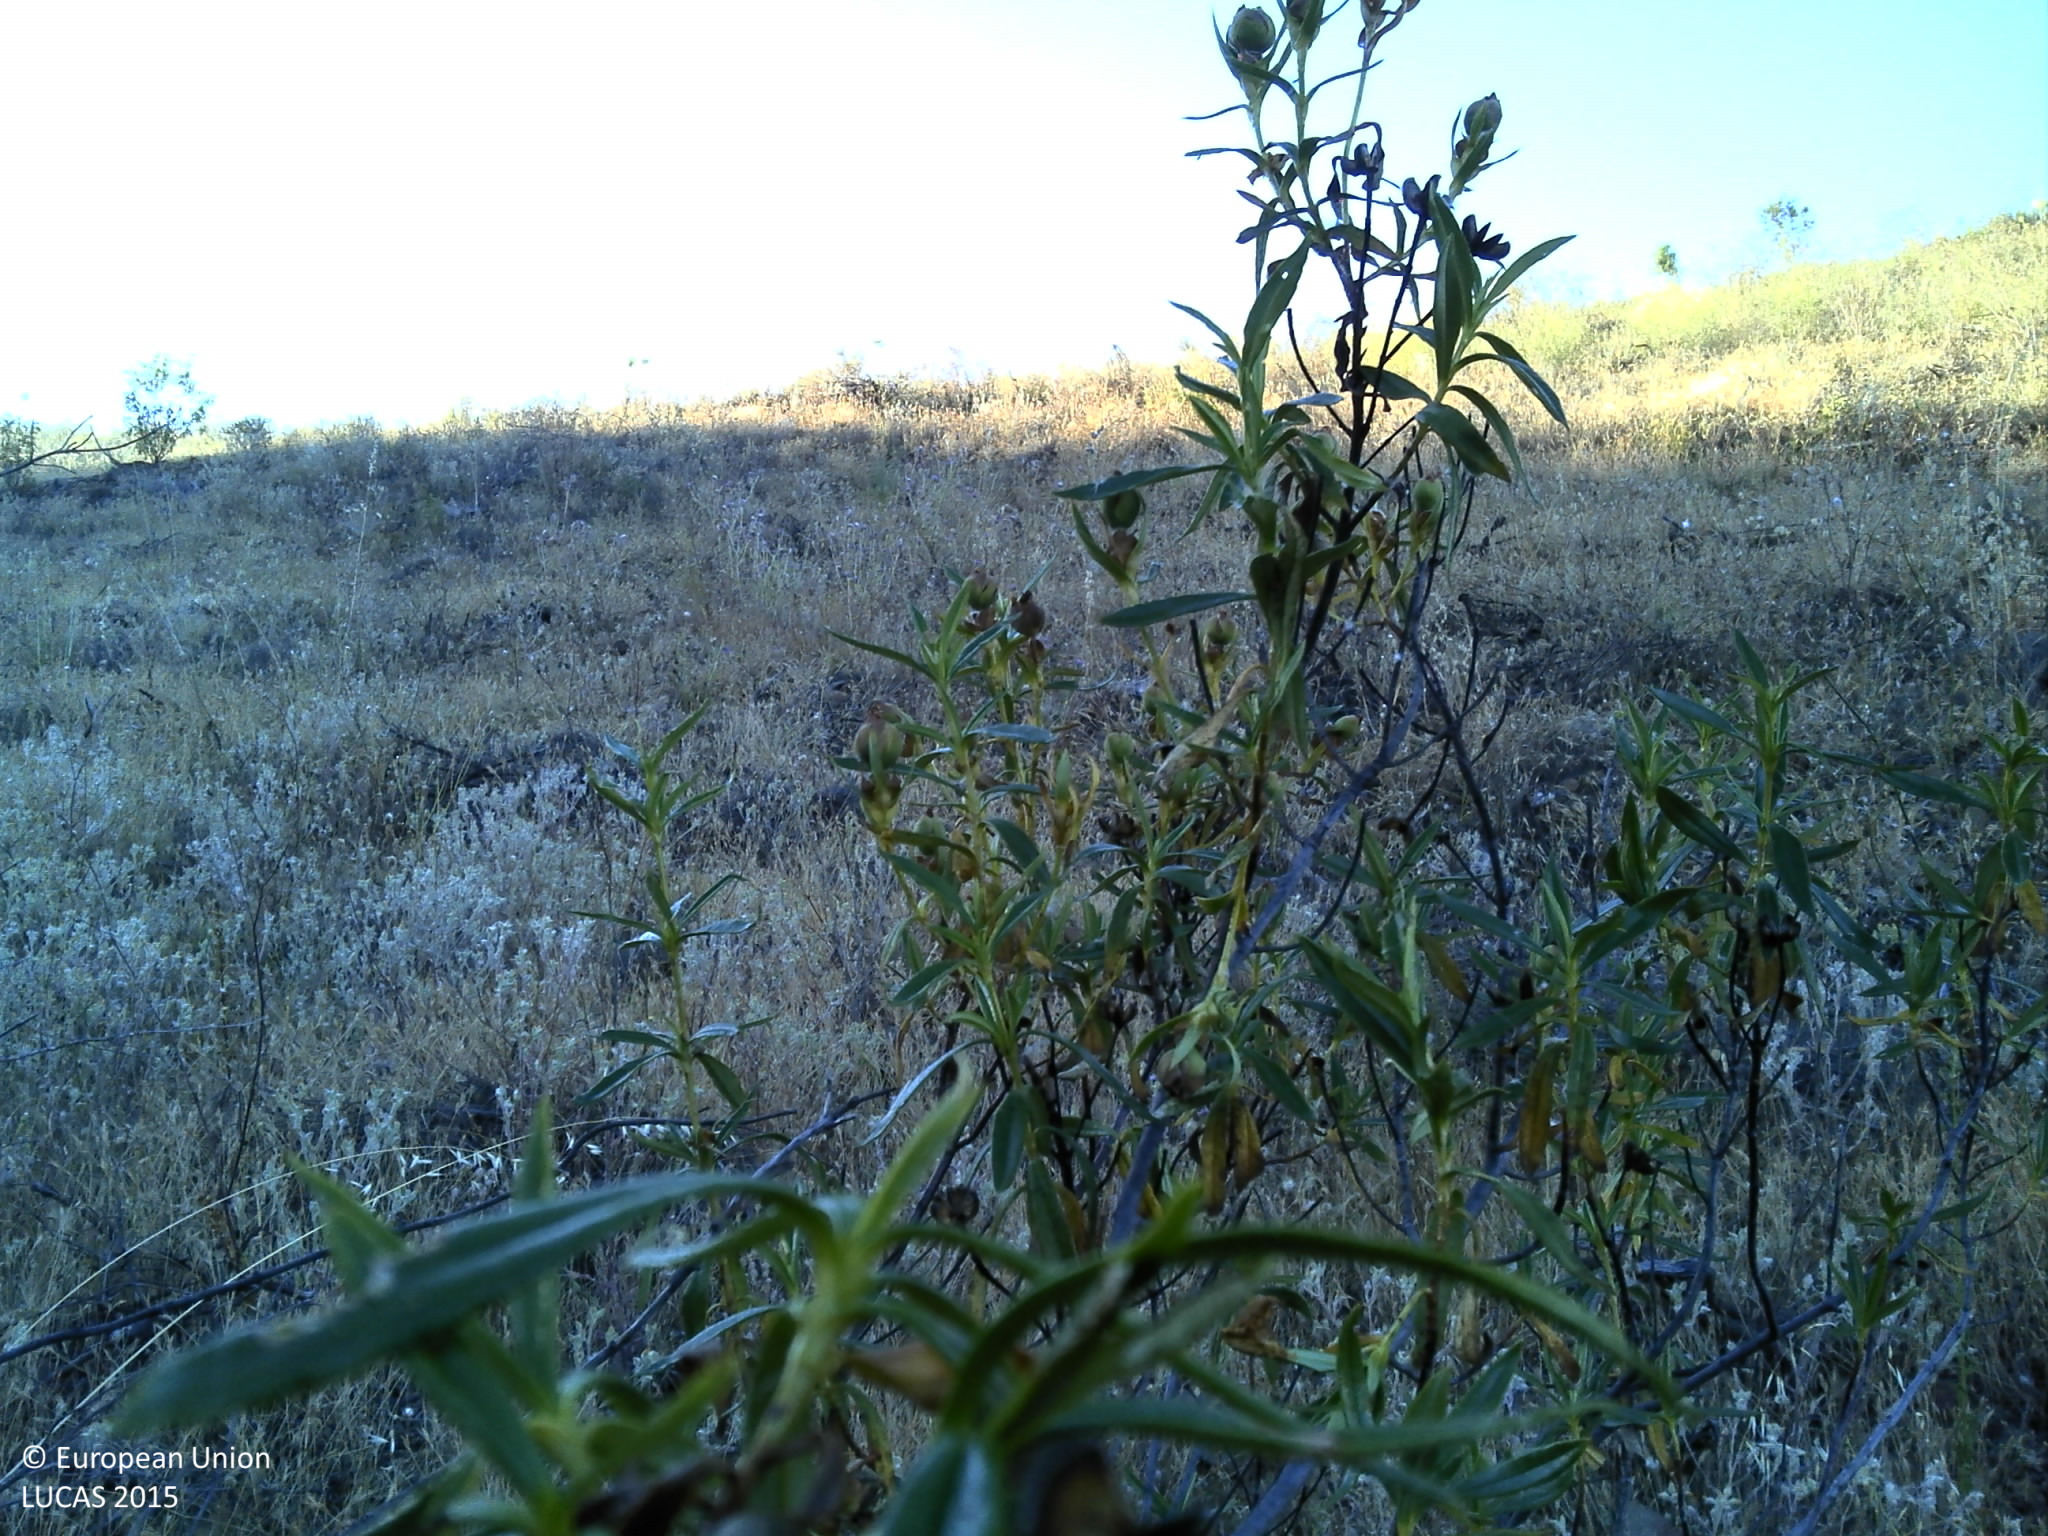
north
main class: Shrubland
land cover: Shrubland without tree cover
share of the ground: > 75 %
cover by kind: shrubs 100 %
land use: Semi-natural and natural areas not in use
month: May
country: PT
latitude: 37.4574
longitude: -7.5204
